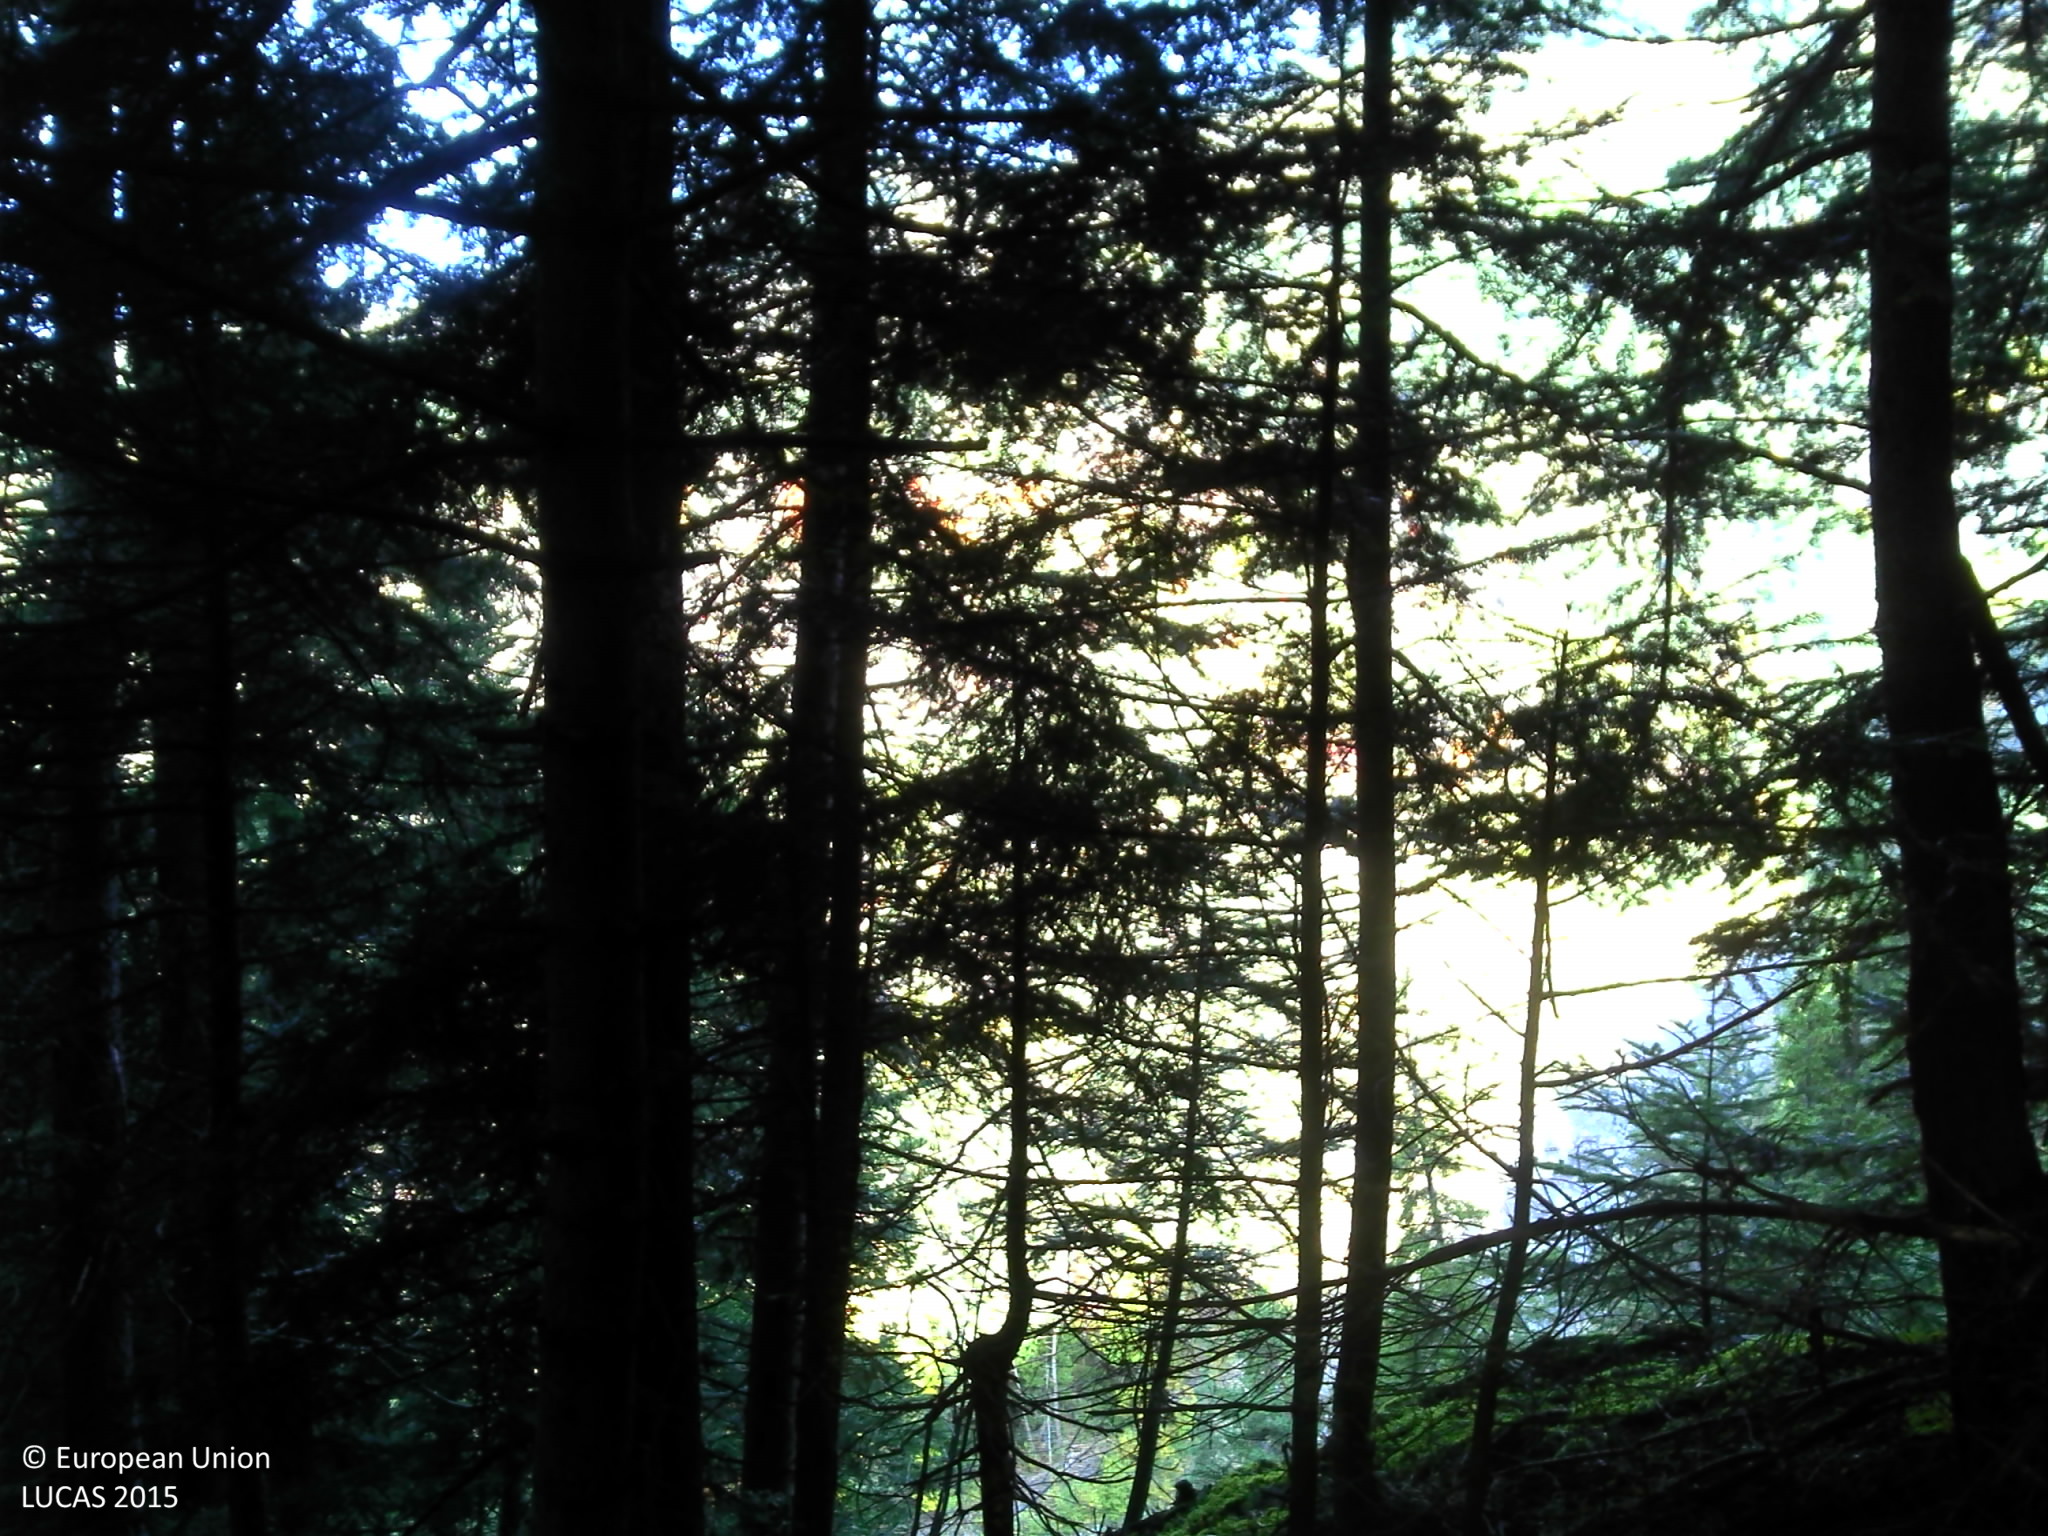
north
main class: Woodland
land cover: Spruce dominated coniferous woodland
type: alpine coniferous forest
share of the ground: > 75 %
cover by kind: coniferous forest trees 95 %, consolidated bare surface 5 %
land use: Forestry
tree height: > 5 m
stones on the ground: < 10 %
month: October
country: FR
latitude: 45.3337
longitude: 6.3683
